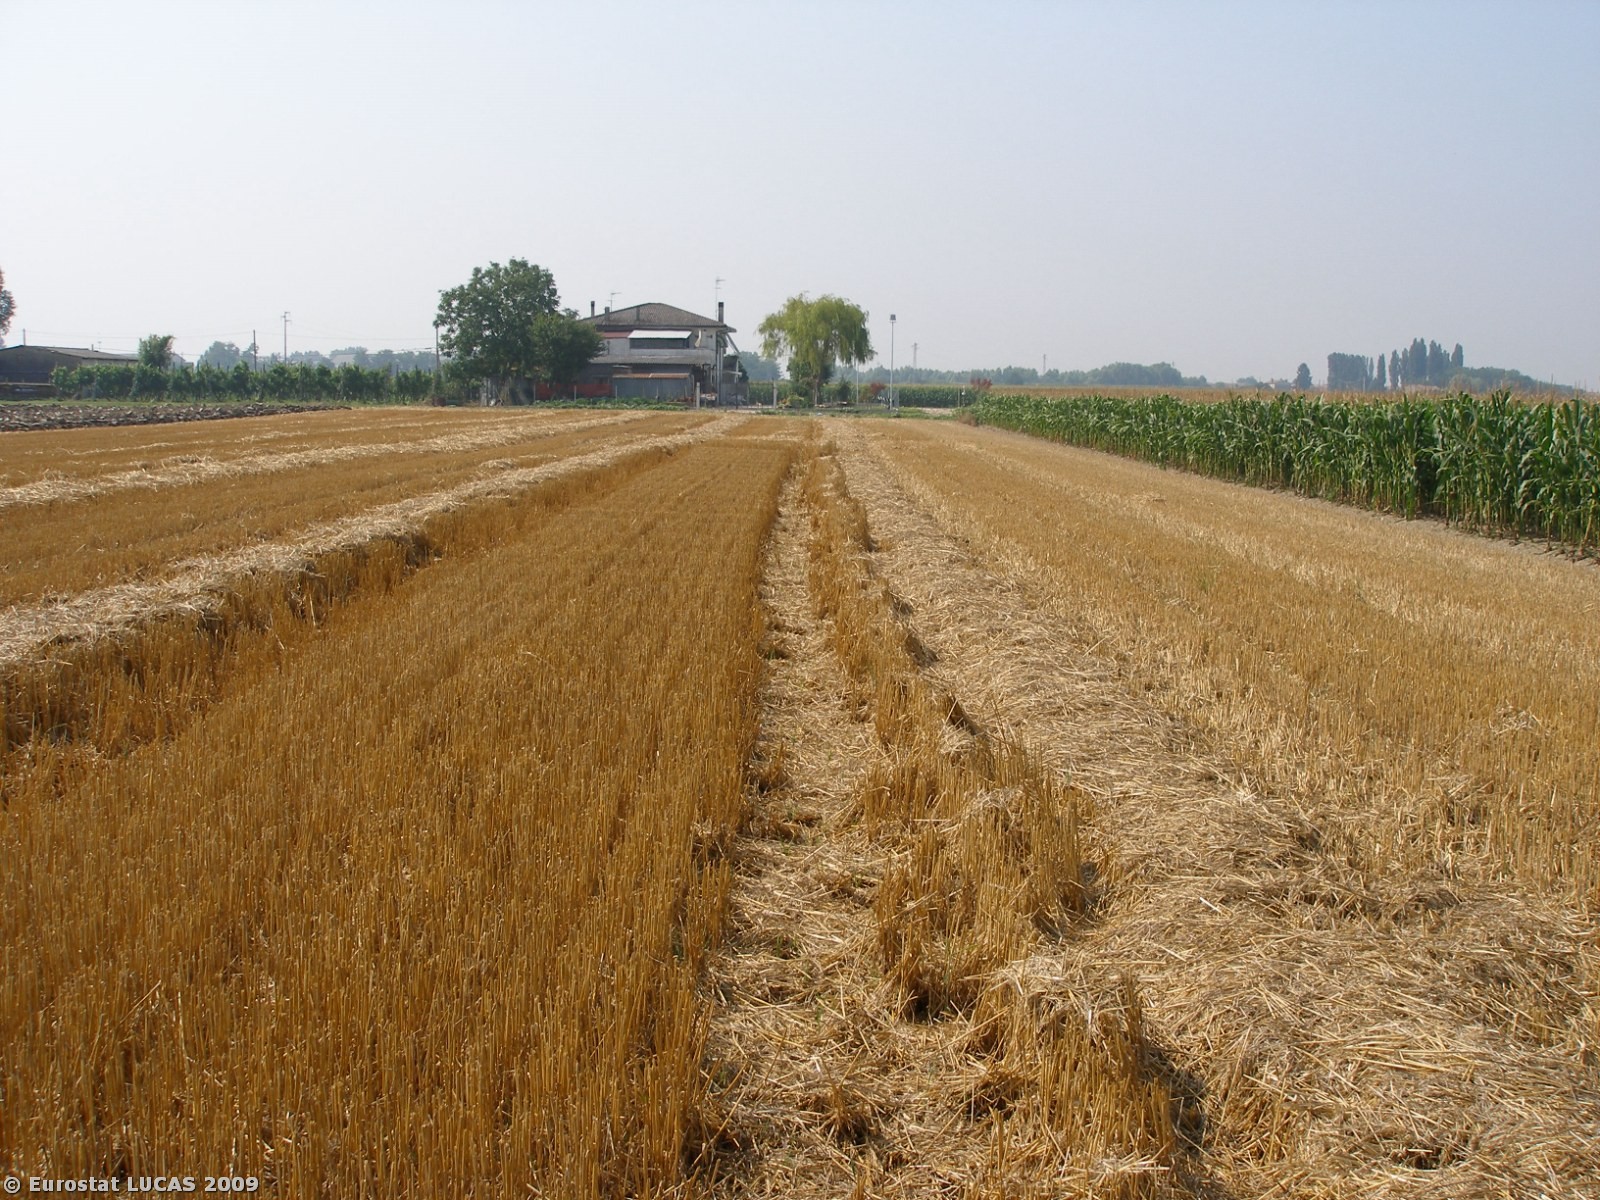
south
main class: Cropland
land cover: Common wheat
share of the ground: < 10 %
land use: Agriculture (excluding fallow land and kitchen gardens)
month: July
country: IT
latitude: 44.9673
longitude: 11.7337
